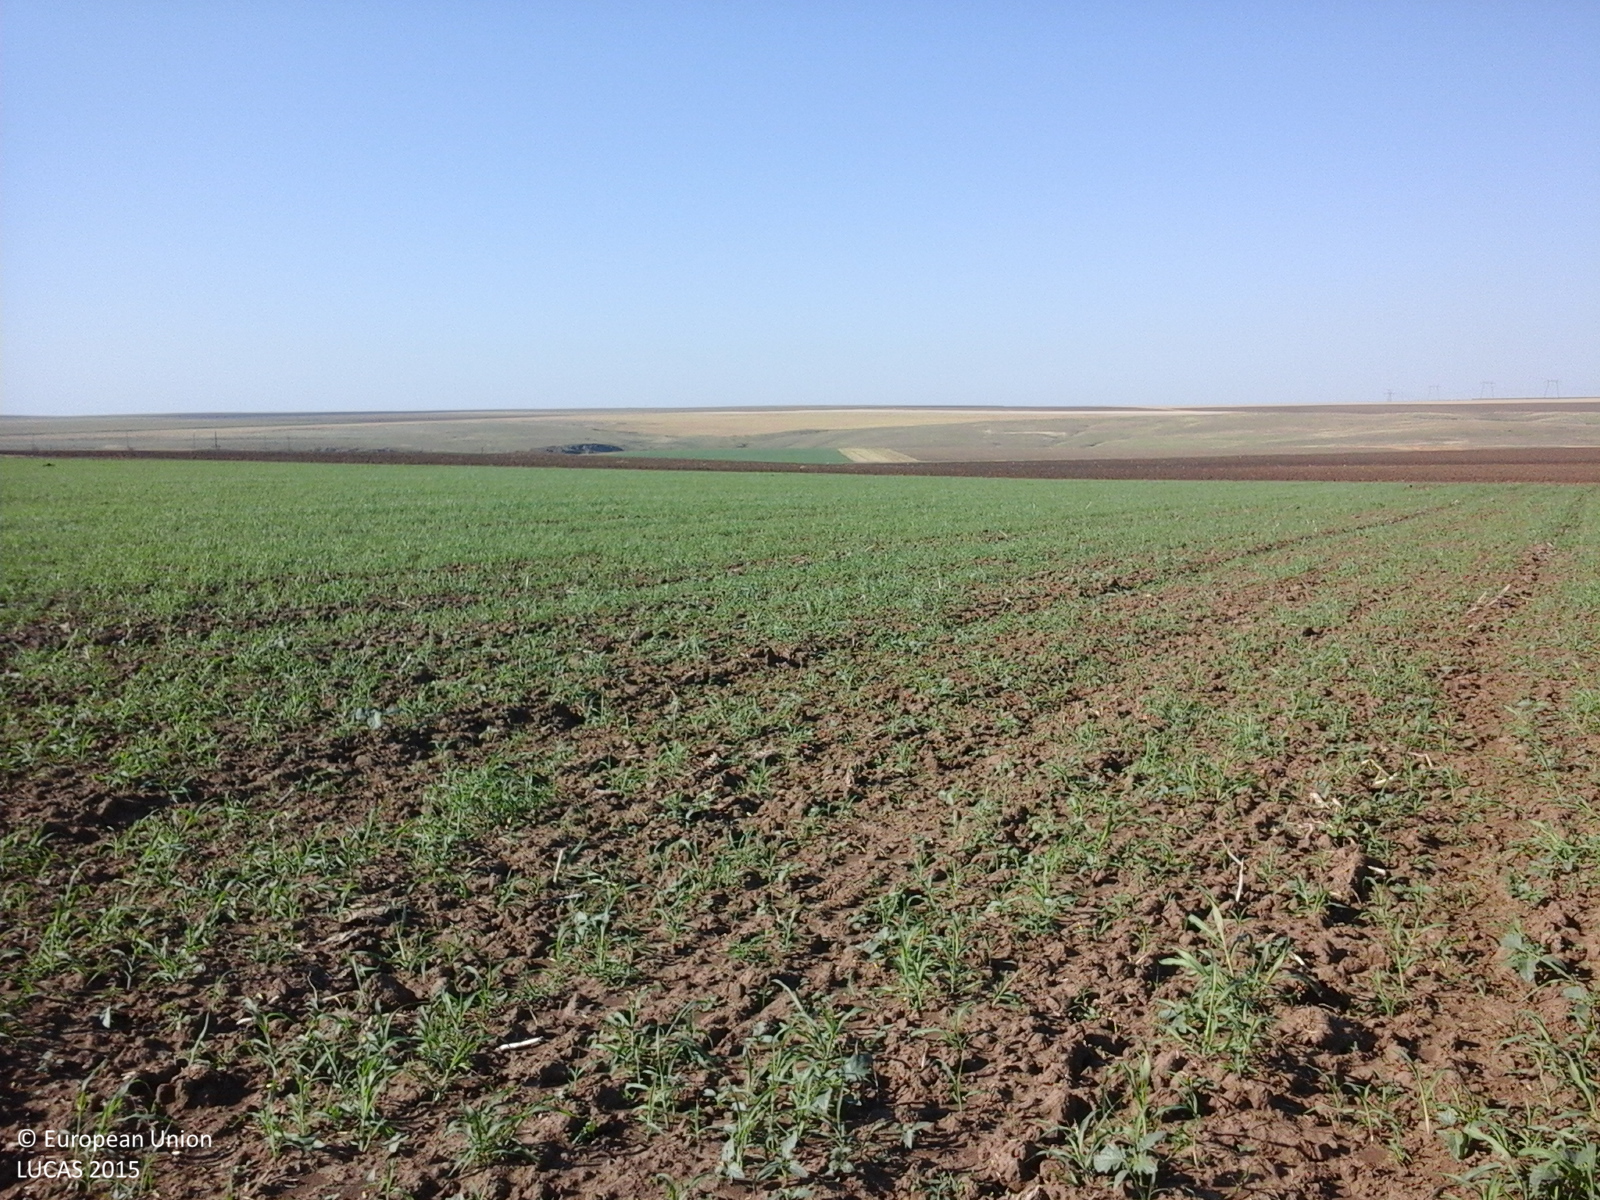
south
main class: Grassland
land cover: Spontaneously vegetated surfaces
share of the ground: > 75 %
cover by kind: herbaceous plants 100 %
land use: Agriculture (excluding fallow land and kitchen gardens)
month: August
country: RO
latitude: 44.5496
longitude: 28.6192
